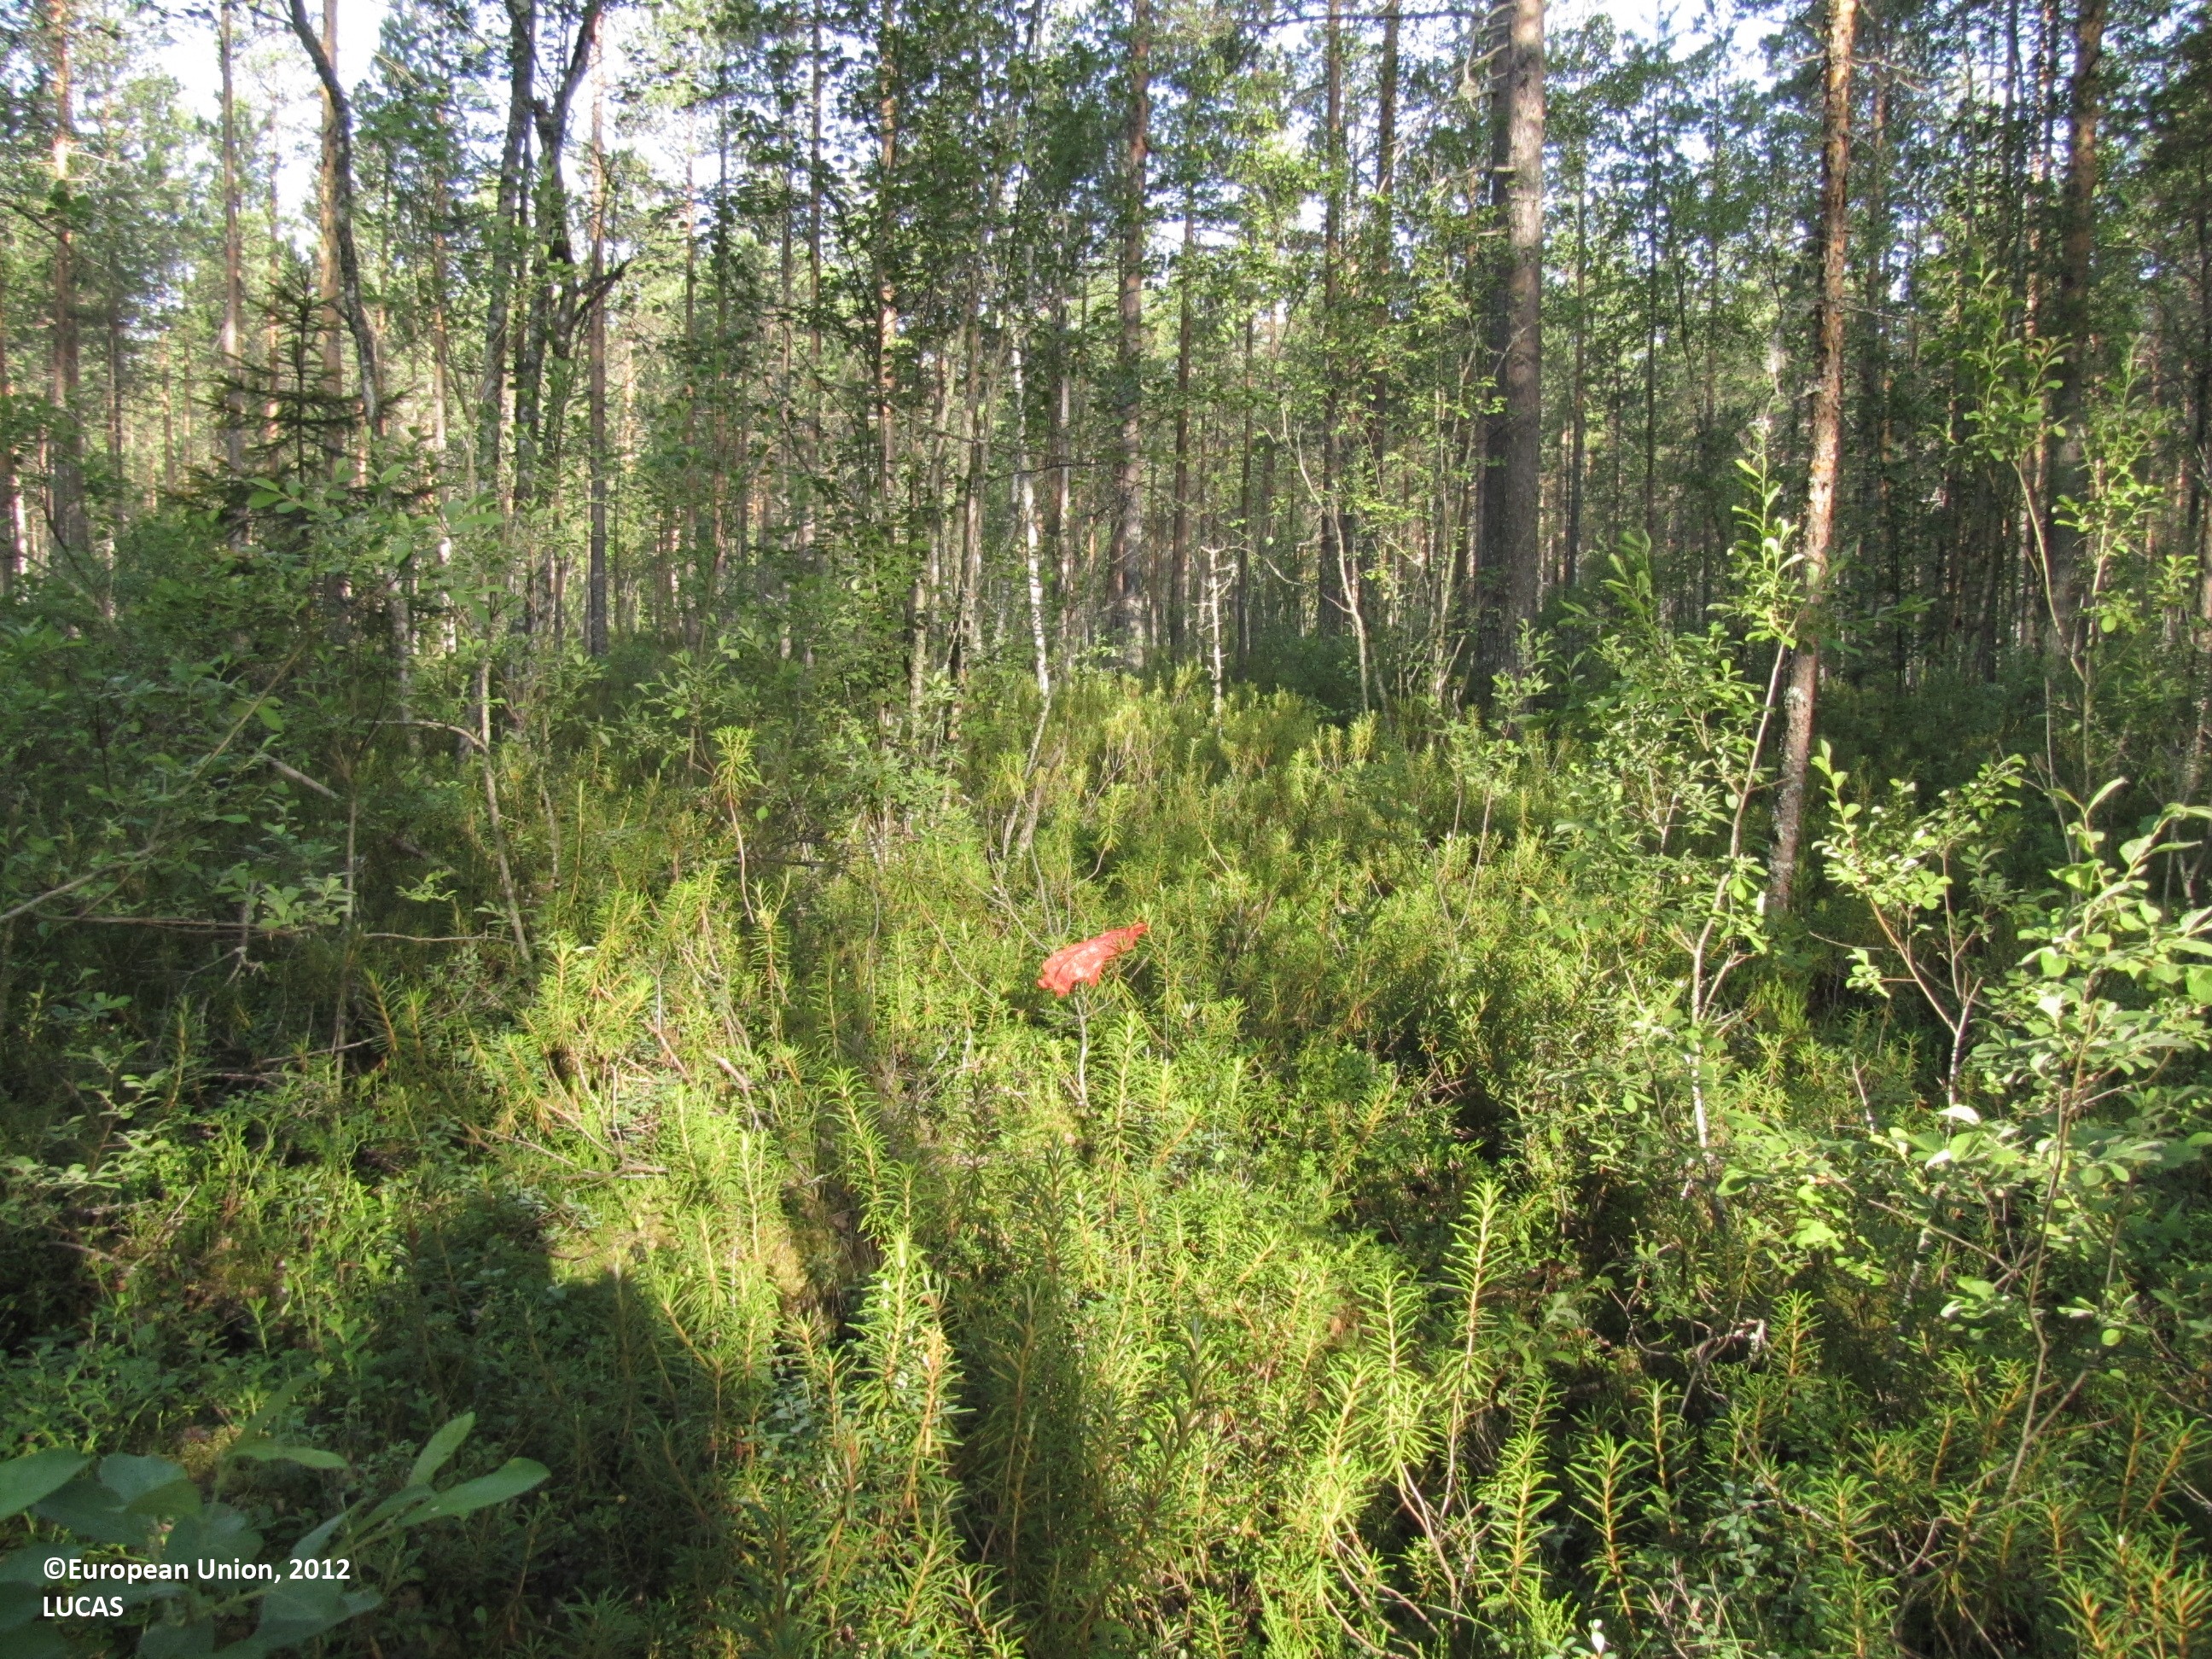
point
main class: Woodland
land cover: Pine dominated coniferous woodland
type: mire and swamp forests
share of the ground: > 75 %
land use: Forestry
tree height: > 5 m
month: July
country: FI
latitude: 62.6062
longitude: 23.2949
